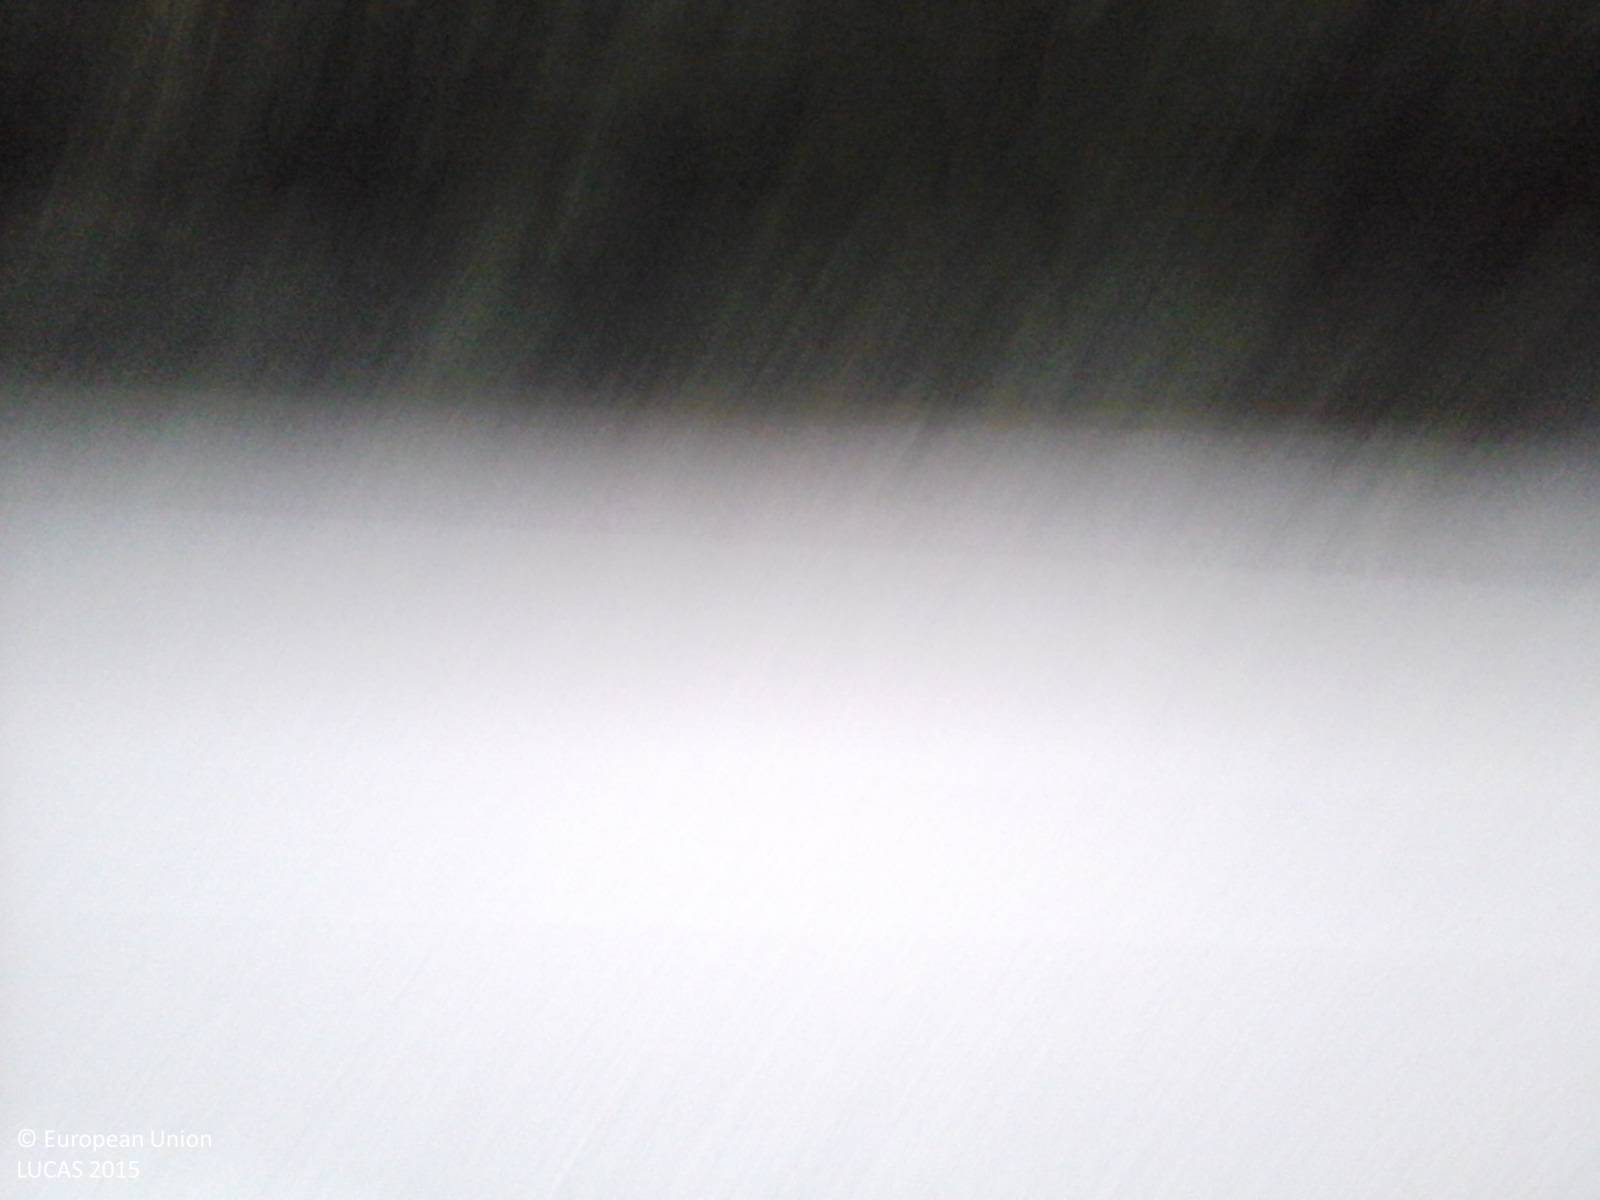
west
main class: Woodland
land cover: Broadleaved woodland
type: thermophilous deciduous forest
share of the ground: > 75 %
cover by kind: broadleaved forest trees 90 %, shrubs 10 %
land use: Forestry
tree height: > 5 m
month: October
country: IT
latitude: 42.7935
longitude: 12.8888
